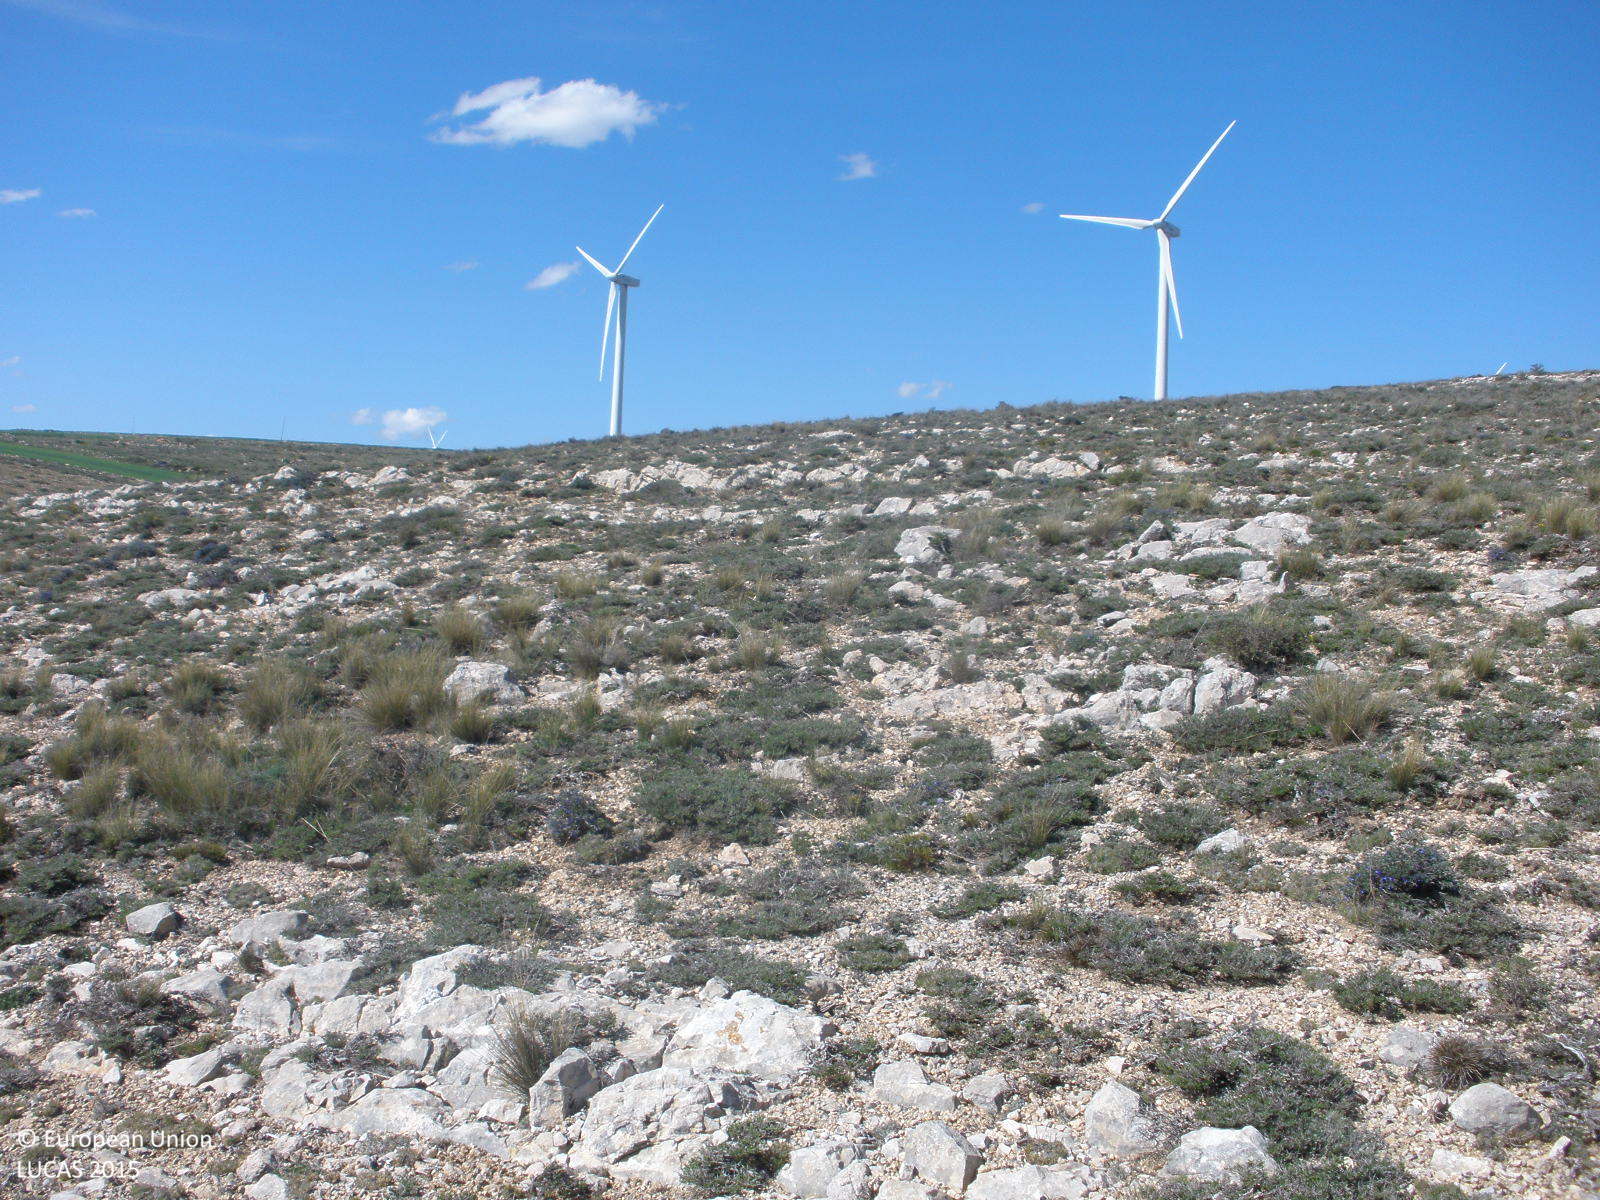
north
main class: Shrubland
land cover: Shrubland without tree cover
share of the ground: 50 - 75 %
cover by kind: shrubs 40 %, consolidated bare surface 35 %, herbaceous plants 25 %
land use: Semi-natural and natural areas not in use
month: May
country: ES
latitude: 40.6836
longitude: -0.8624
